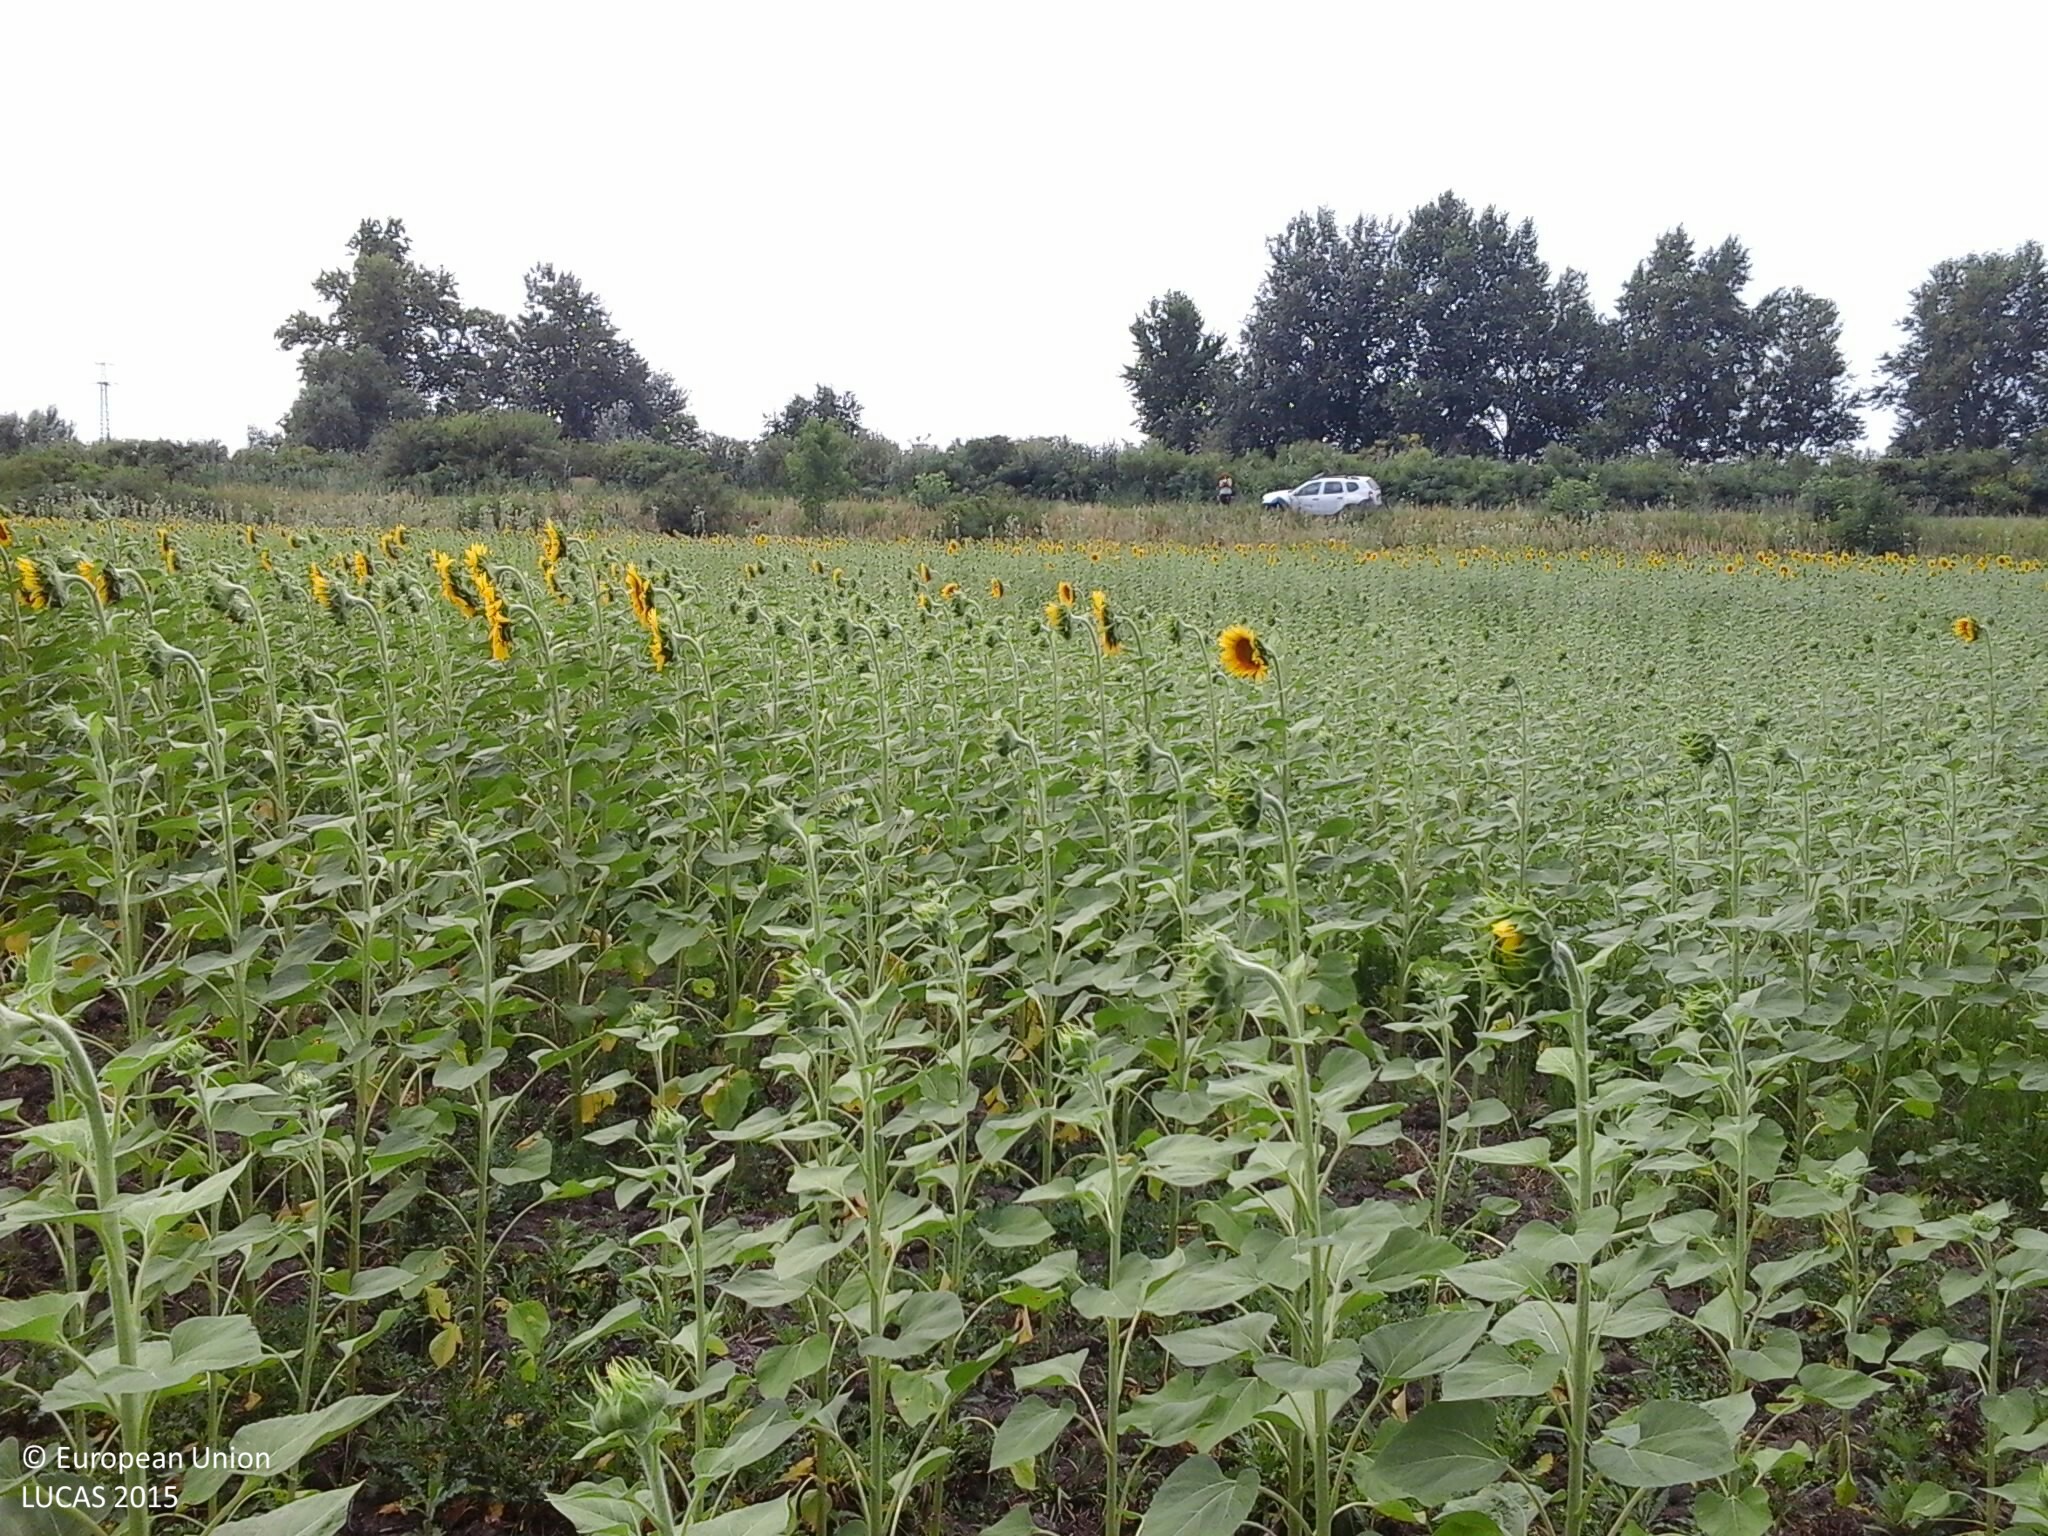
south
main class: Cropland
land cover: Sunflower
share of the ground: > 75 %
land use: Agriculture (excluding fallow land and kitchen gardens)
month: July
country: HU
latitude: 47.7754
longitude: 21.0480
